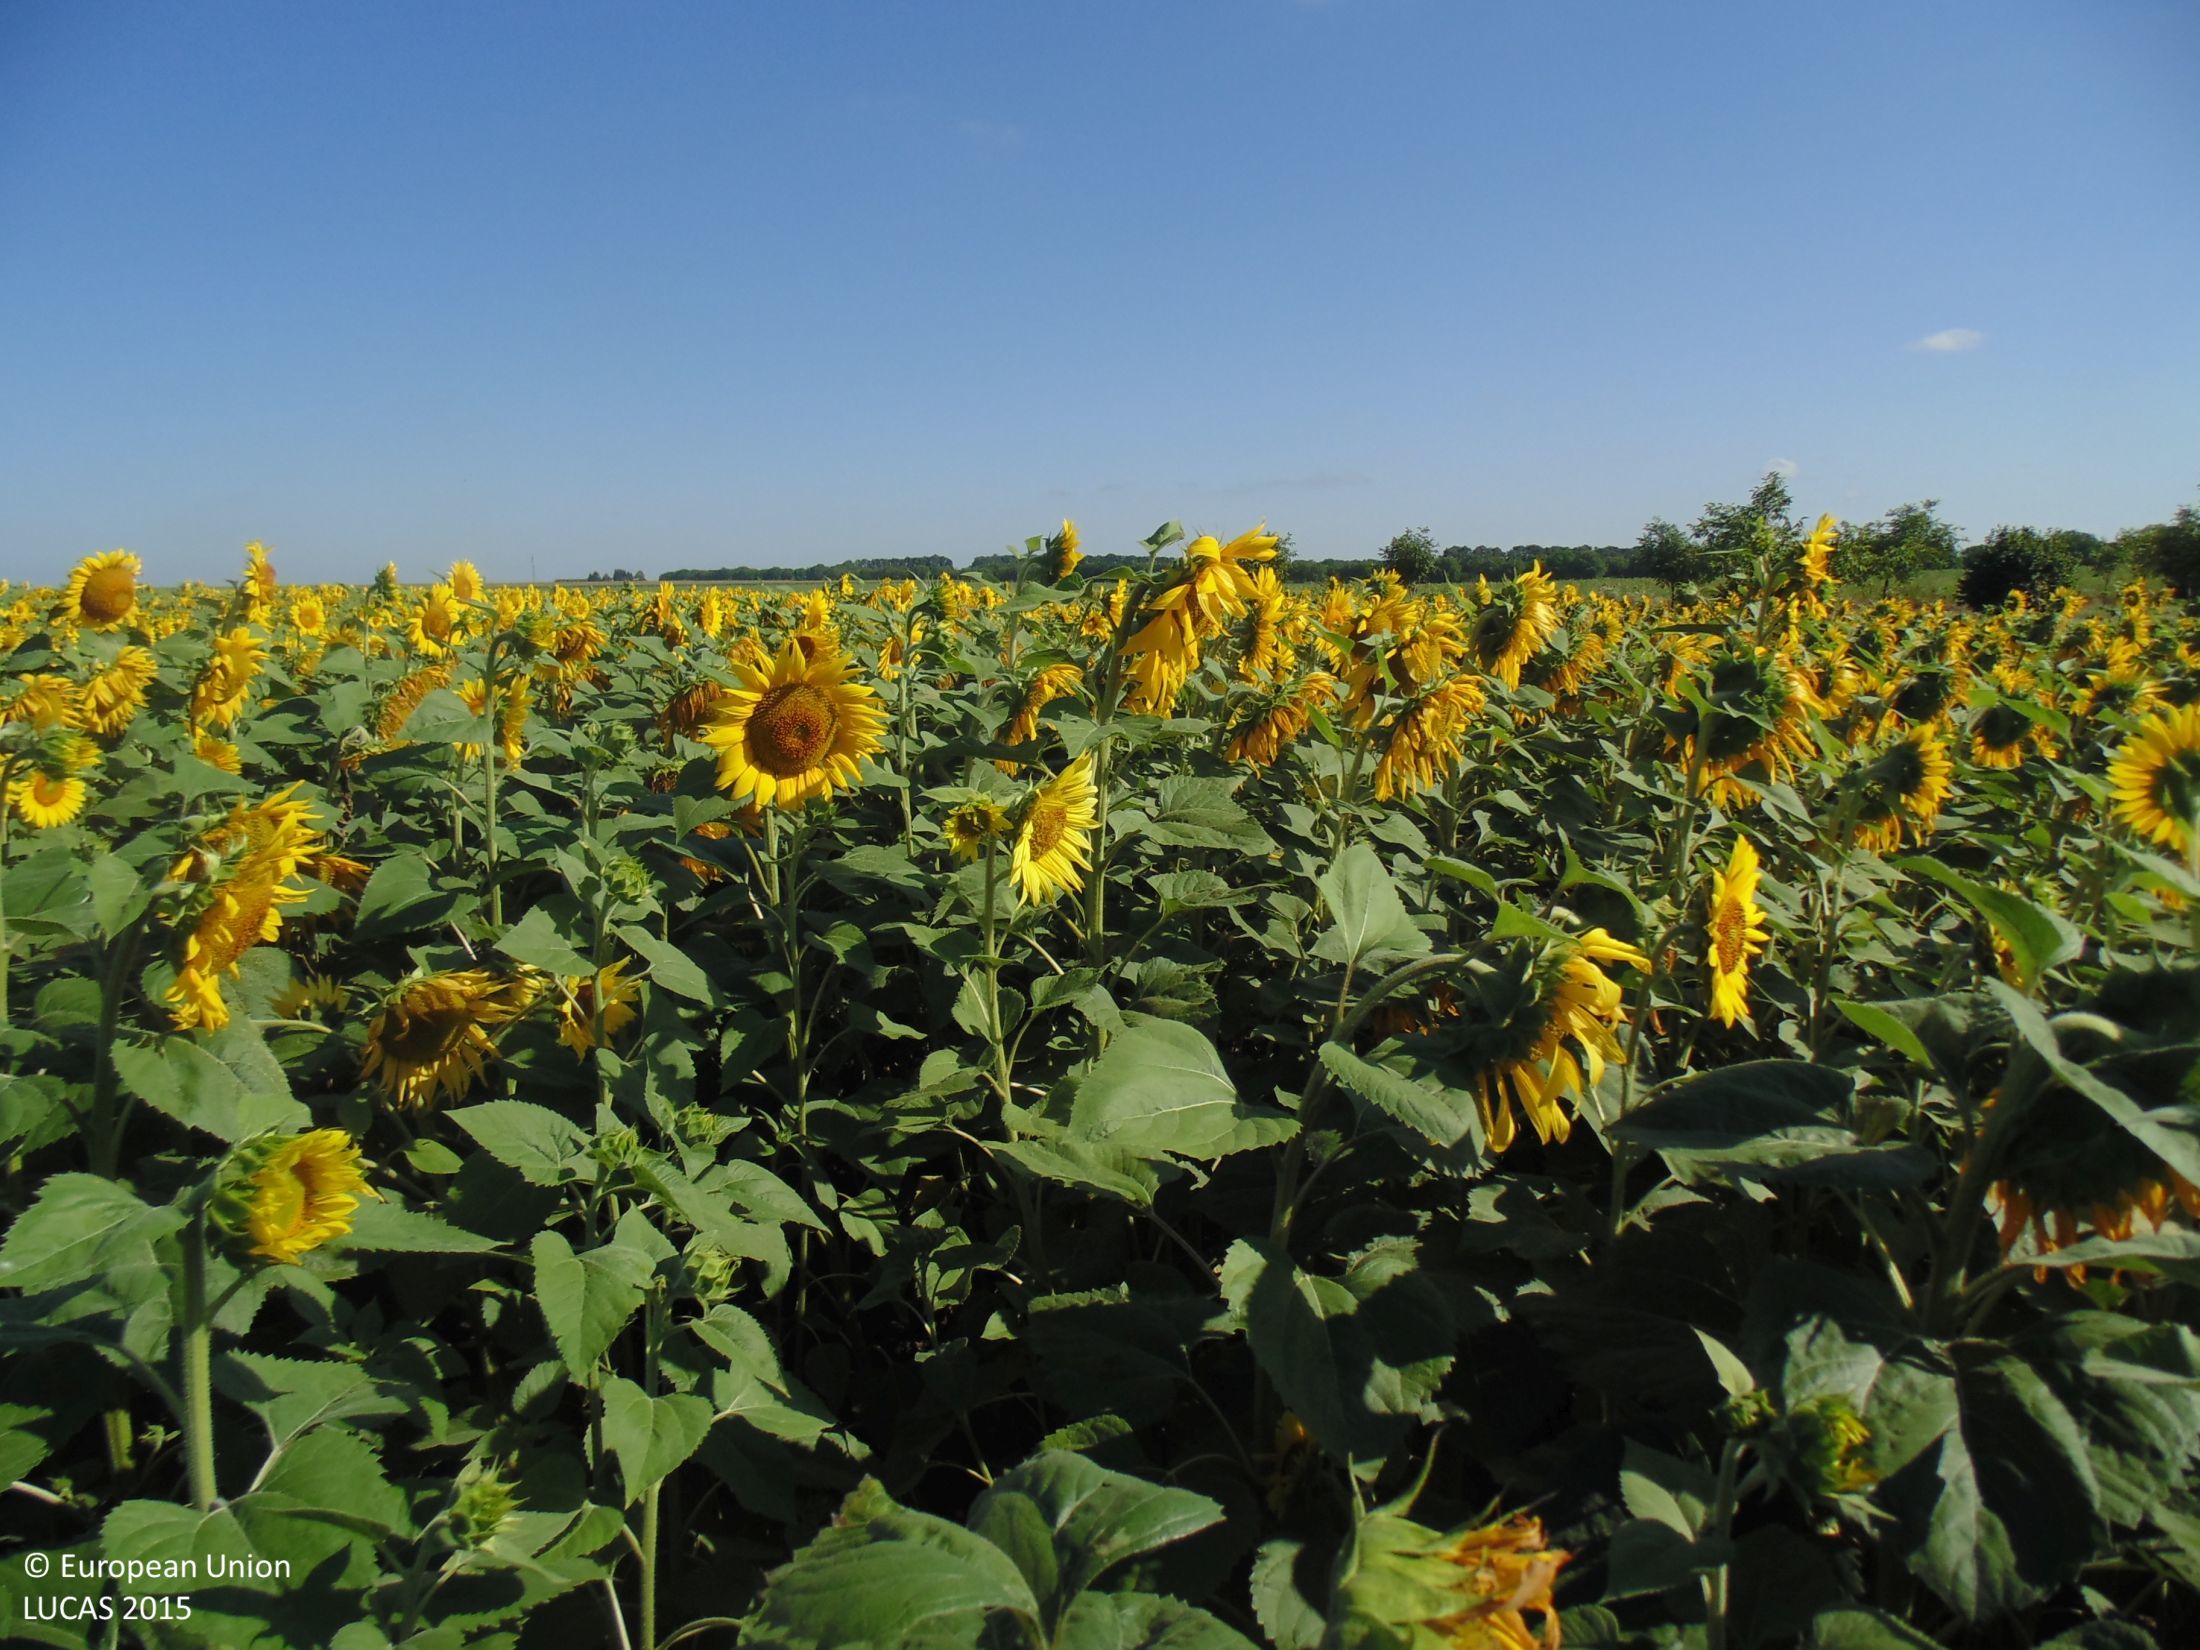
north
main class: Cropland
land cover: Sunflower
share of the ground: > 75 %
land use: Agriculture (excluding fallow land and kitchen gardens)
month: July
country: BG
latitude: 43.4561
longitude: 27.9267
